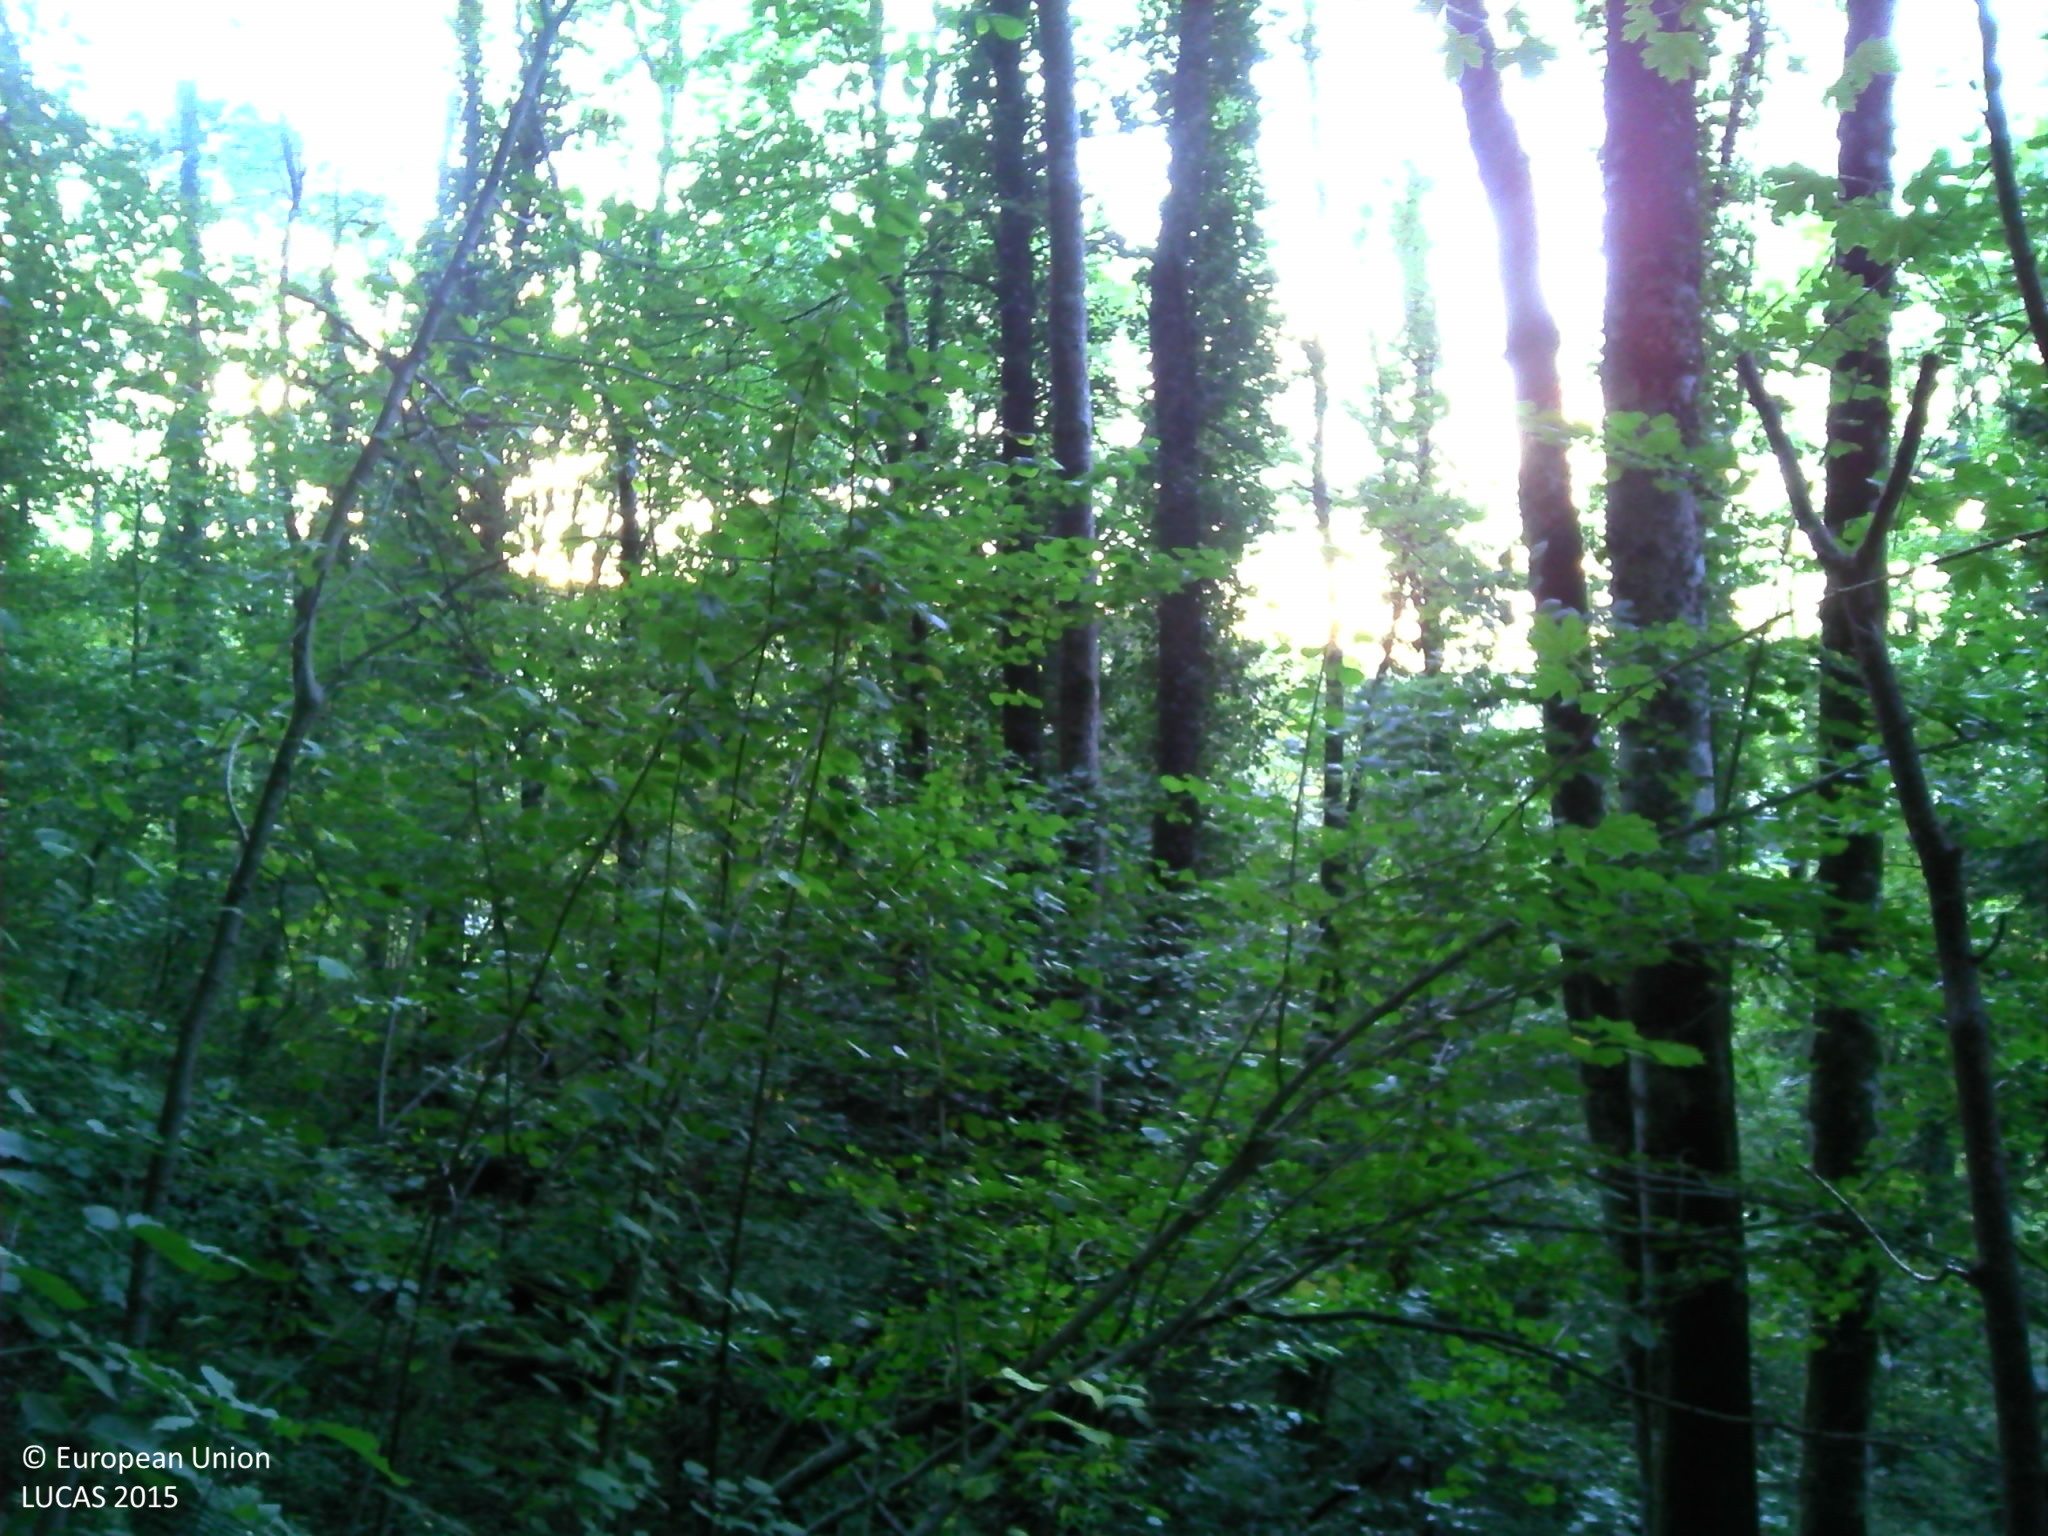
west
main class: Woodland
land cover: Broadleaved woodland
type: mesophytic deciduous forest
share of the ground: > 75 %
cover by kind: broadleaved forest trees 90 %, shrubs 5 %, herbaceous plants 5 %
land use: Forestry
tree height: > 5 m
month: September
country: FR
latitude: 47.3145
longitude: 6.8667
